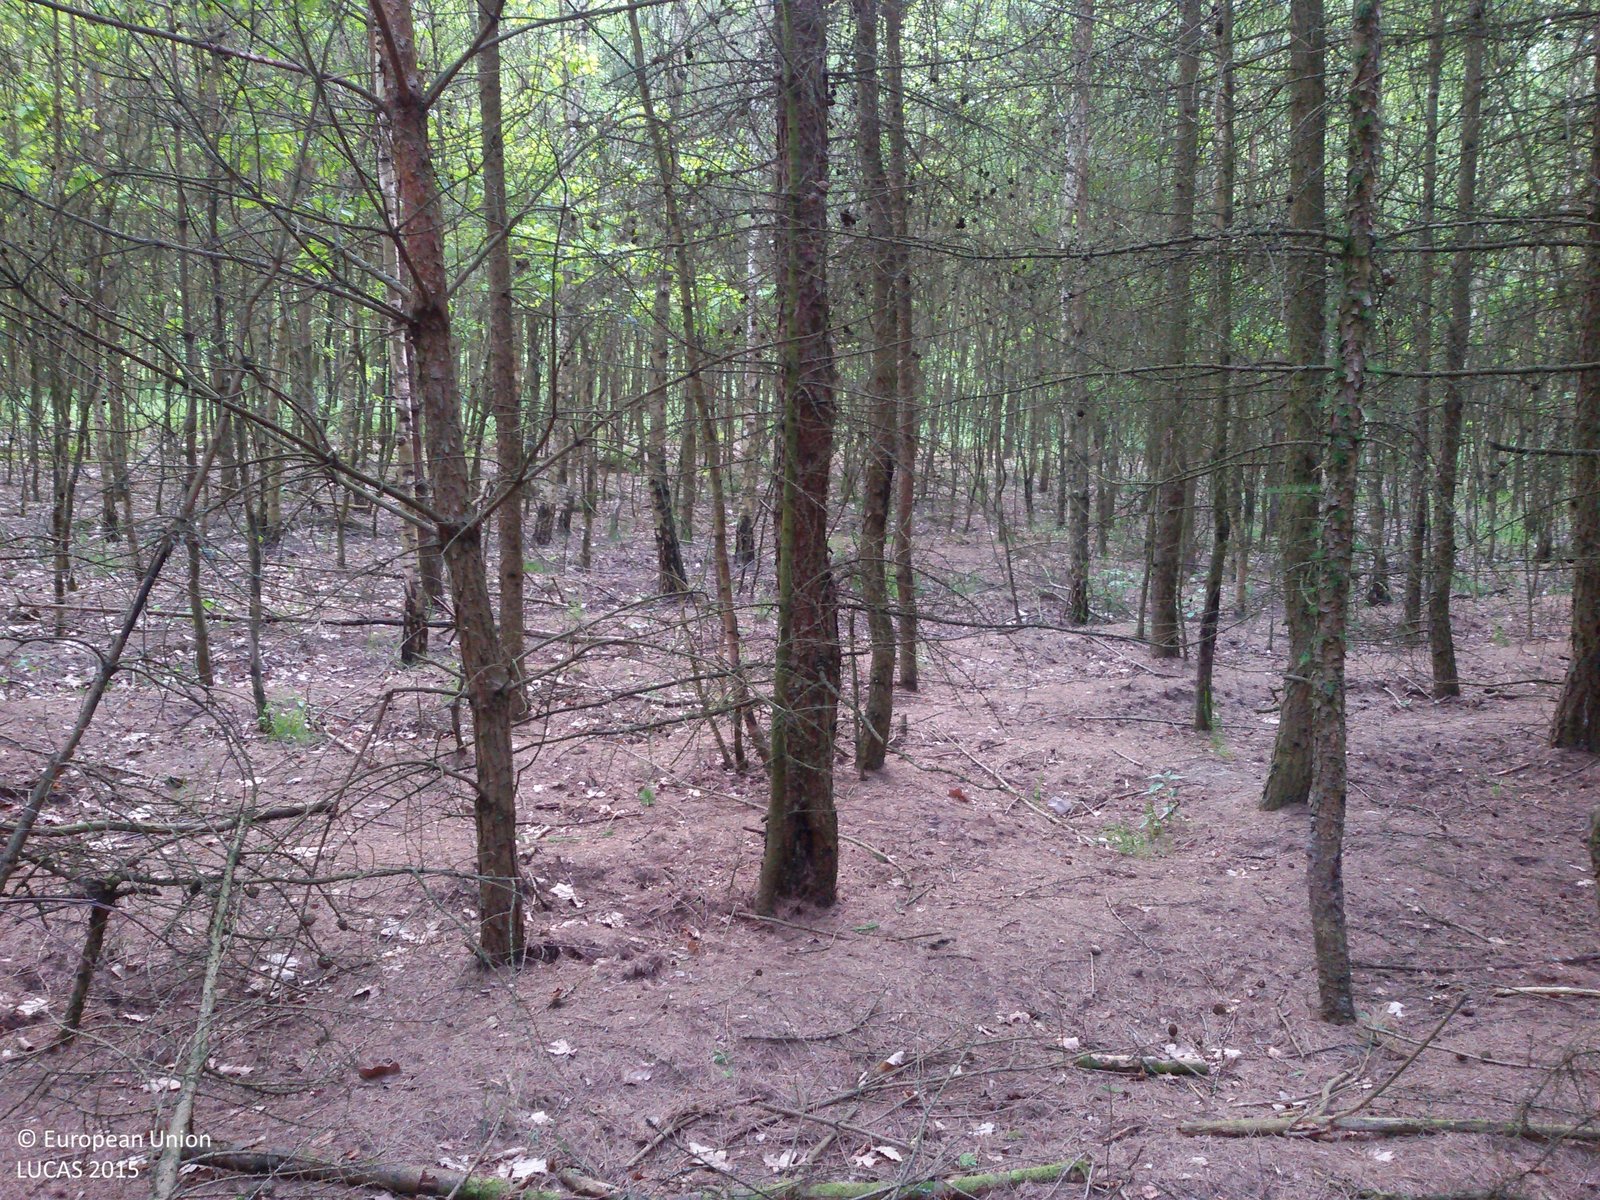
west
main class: Woodland
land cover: Pine dominated coniferous woodland
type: hemiboreal forest and nemoral coniferous forest and mixed broadleaved-coniferous forest
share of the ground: > 75 %
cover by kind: coniferous forest trees 100 %
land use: Forestry
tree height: > 5 m
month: May
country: PL
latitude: 53.1317
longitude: 17.2295
